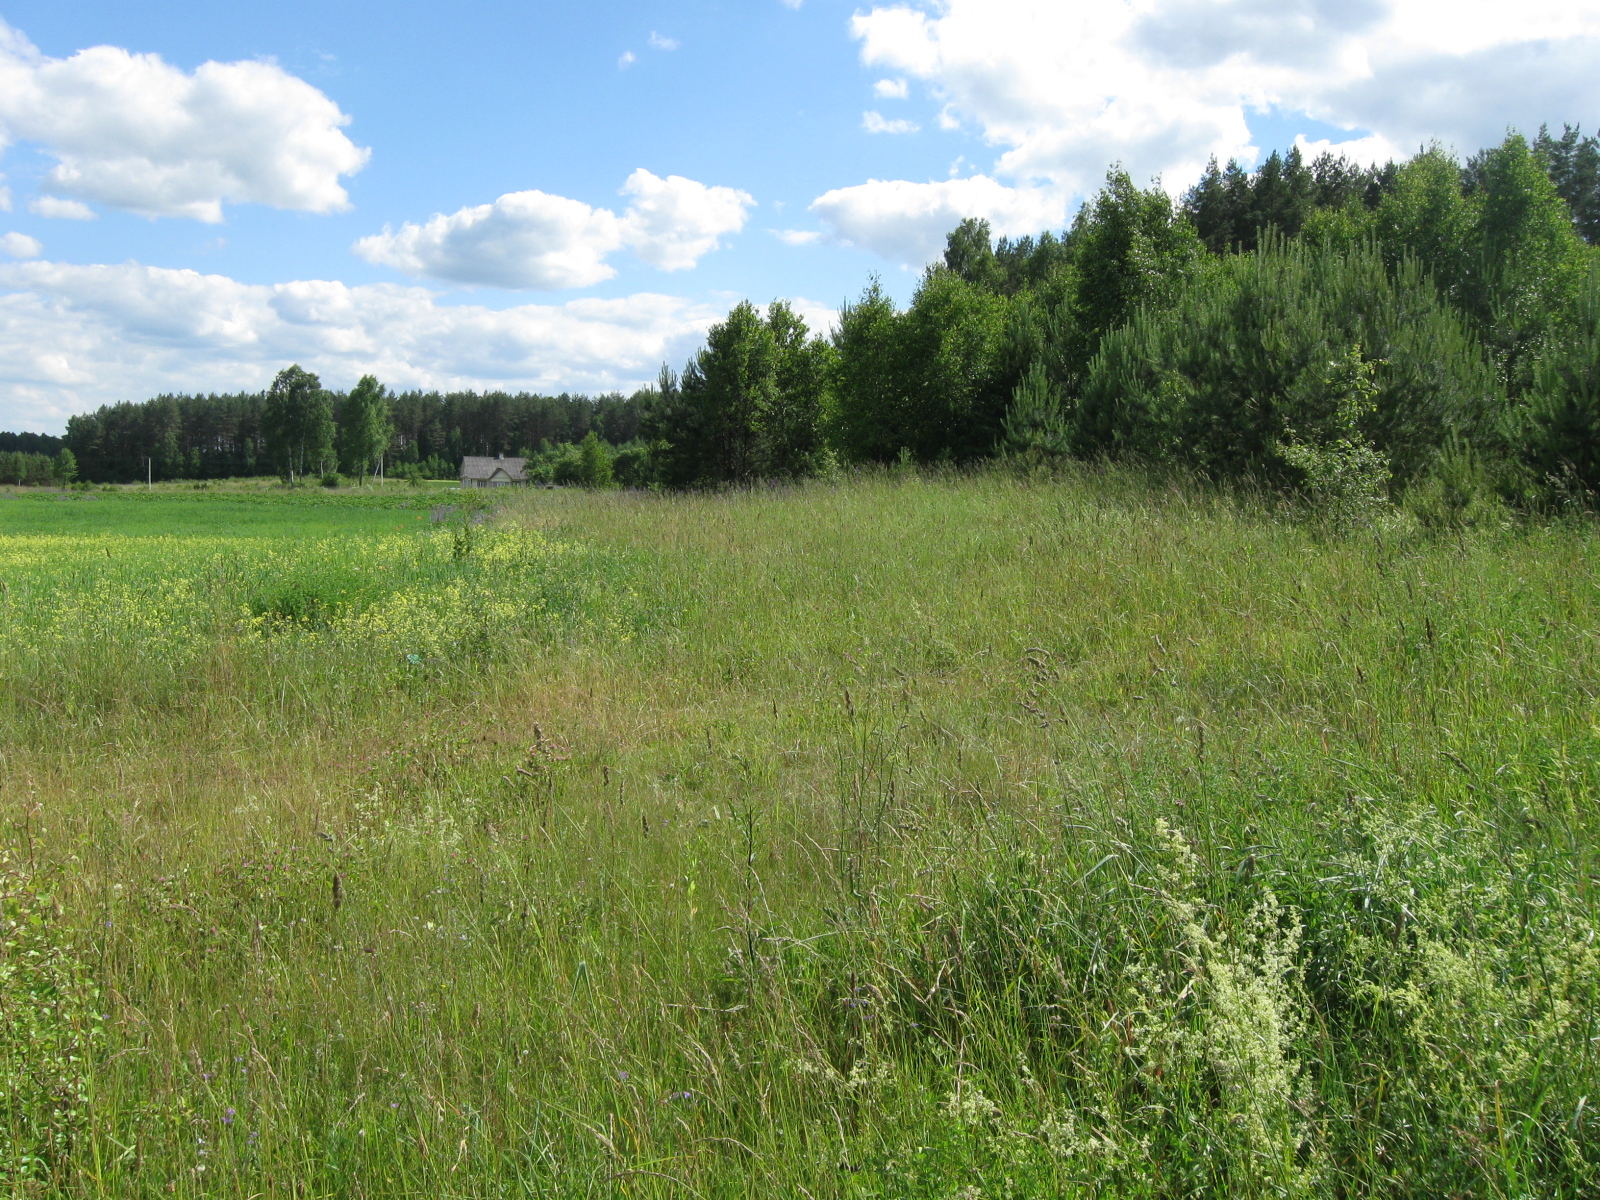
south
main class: Grassland
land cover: Grassland with sparse tree/shrub cover
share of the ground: > 75 %
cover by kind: herbaceous plants 95 %, broadleaved forest trees 5 %
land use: Agriculture (excluding fallow land and kitchen gardens)
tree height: < 5 m
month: June
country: LT
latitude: 54.4964
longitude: 24.6668
